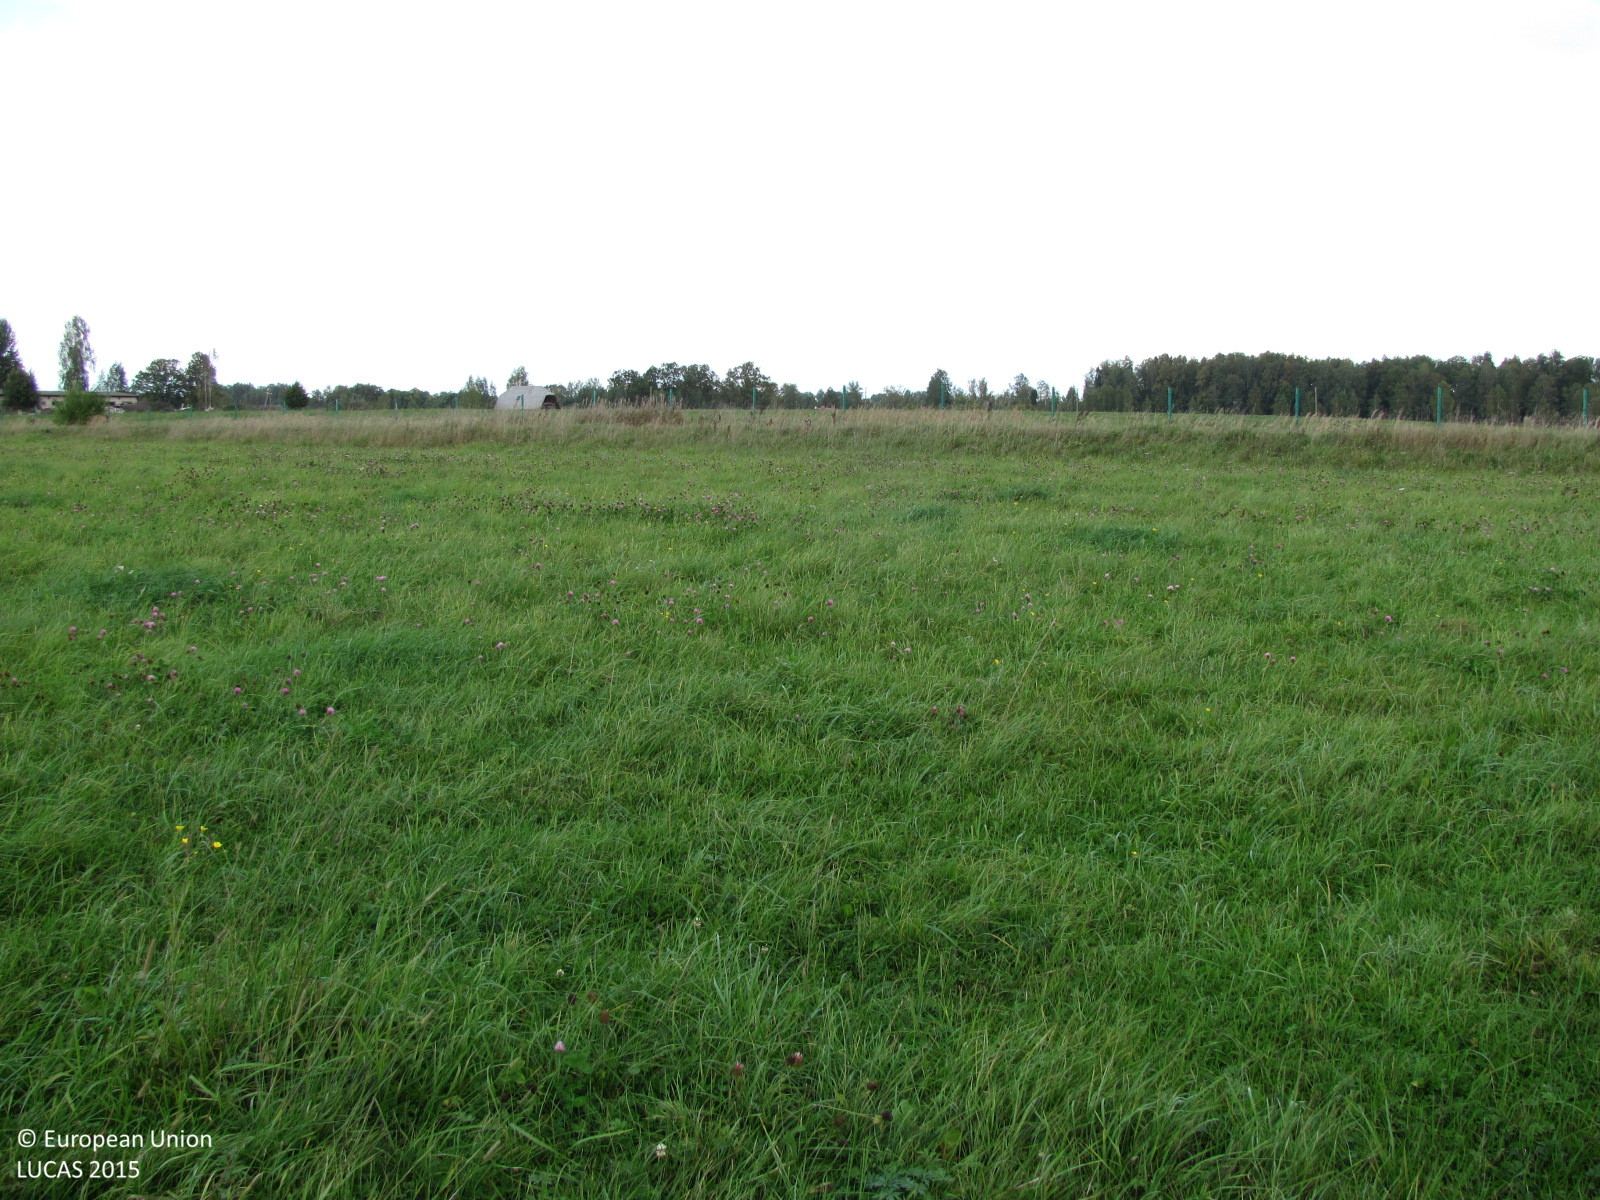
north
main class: Grassland
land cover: Grassland without tree/shrub cover
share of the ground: > 75 %
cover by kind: herbaceous plants 100 %
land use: Agriculture (excluding fallow land and kitchen gardens)
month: September
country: LV
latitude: 56.7315
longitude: 25.1309
